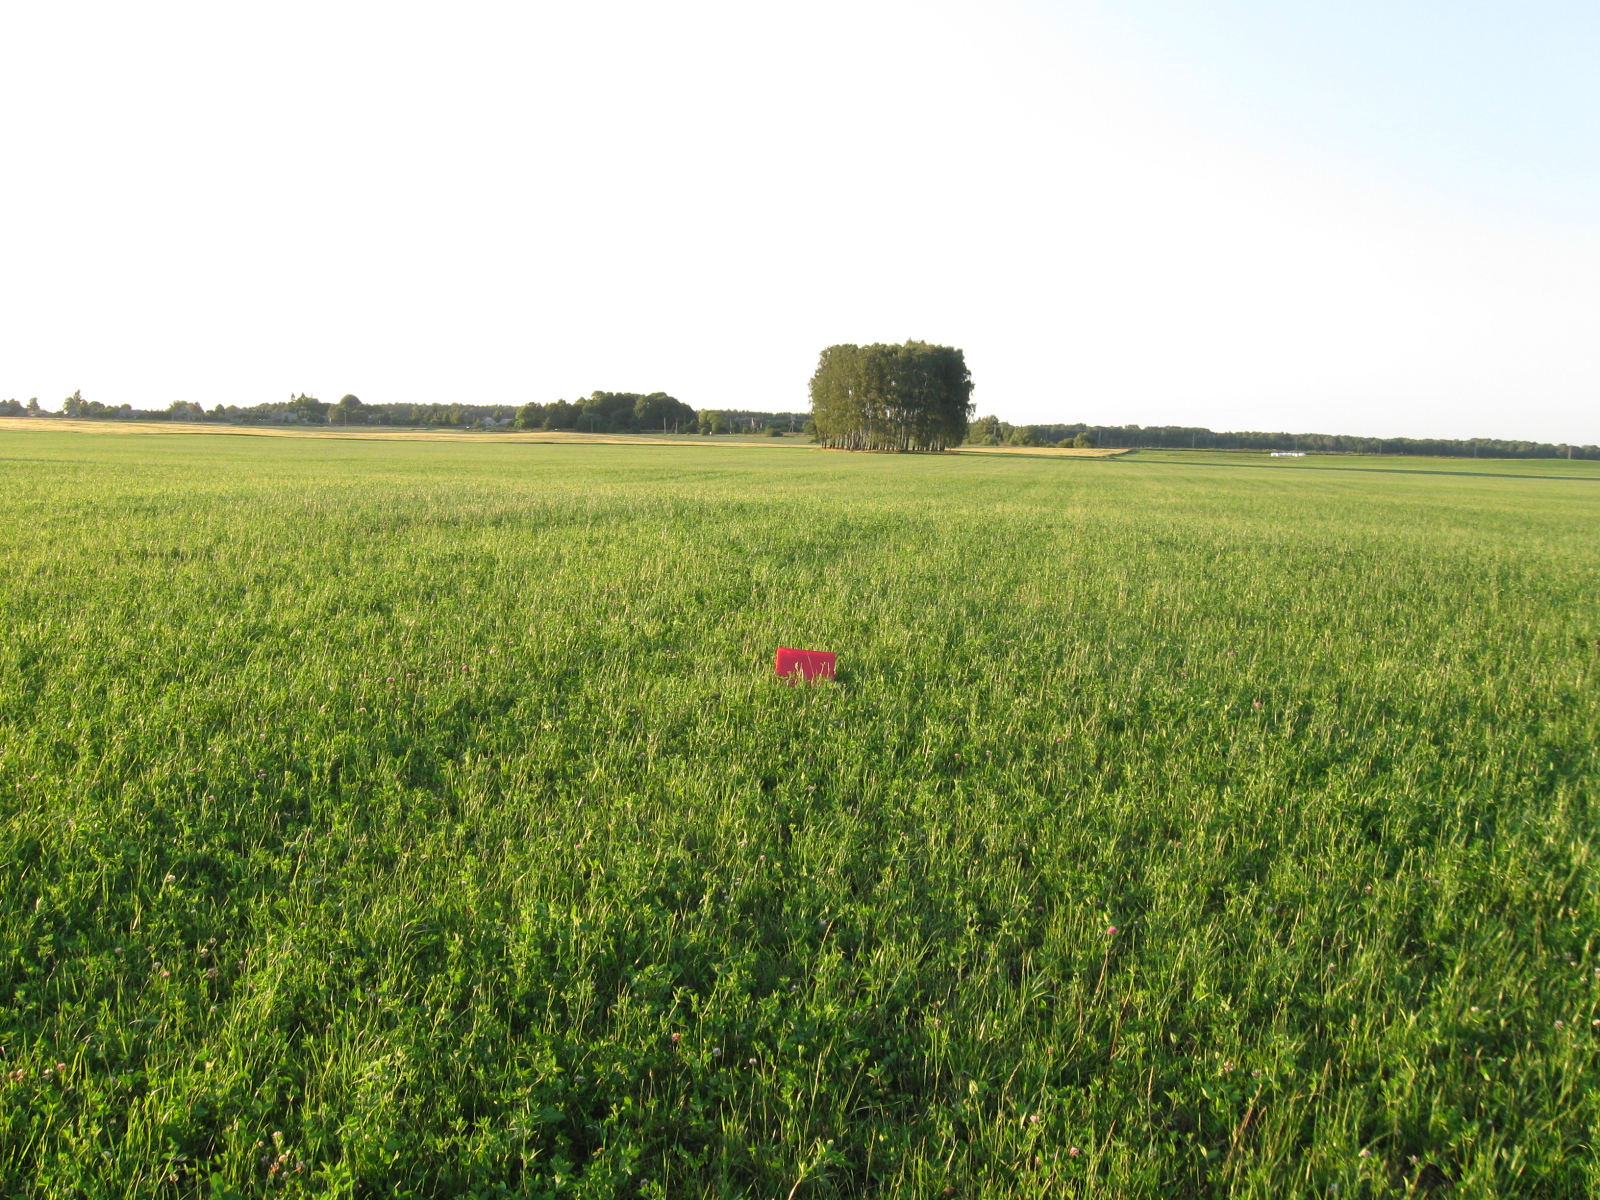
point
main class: Cropland
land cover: Other leguminous and mixtures for fodder
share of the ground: > 75 %
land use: Agriculture (excluding fallow land and kitchen gardens)
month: July
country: LT
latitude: 55.0900
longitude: 23.6360
